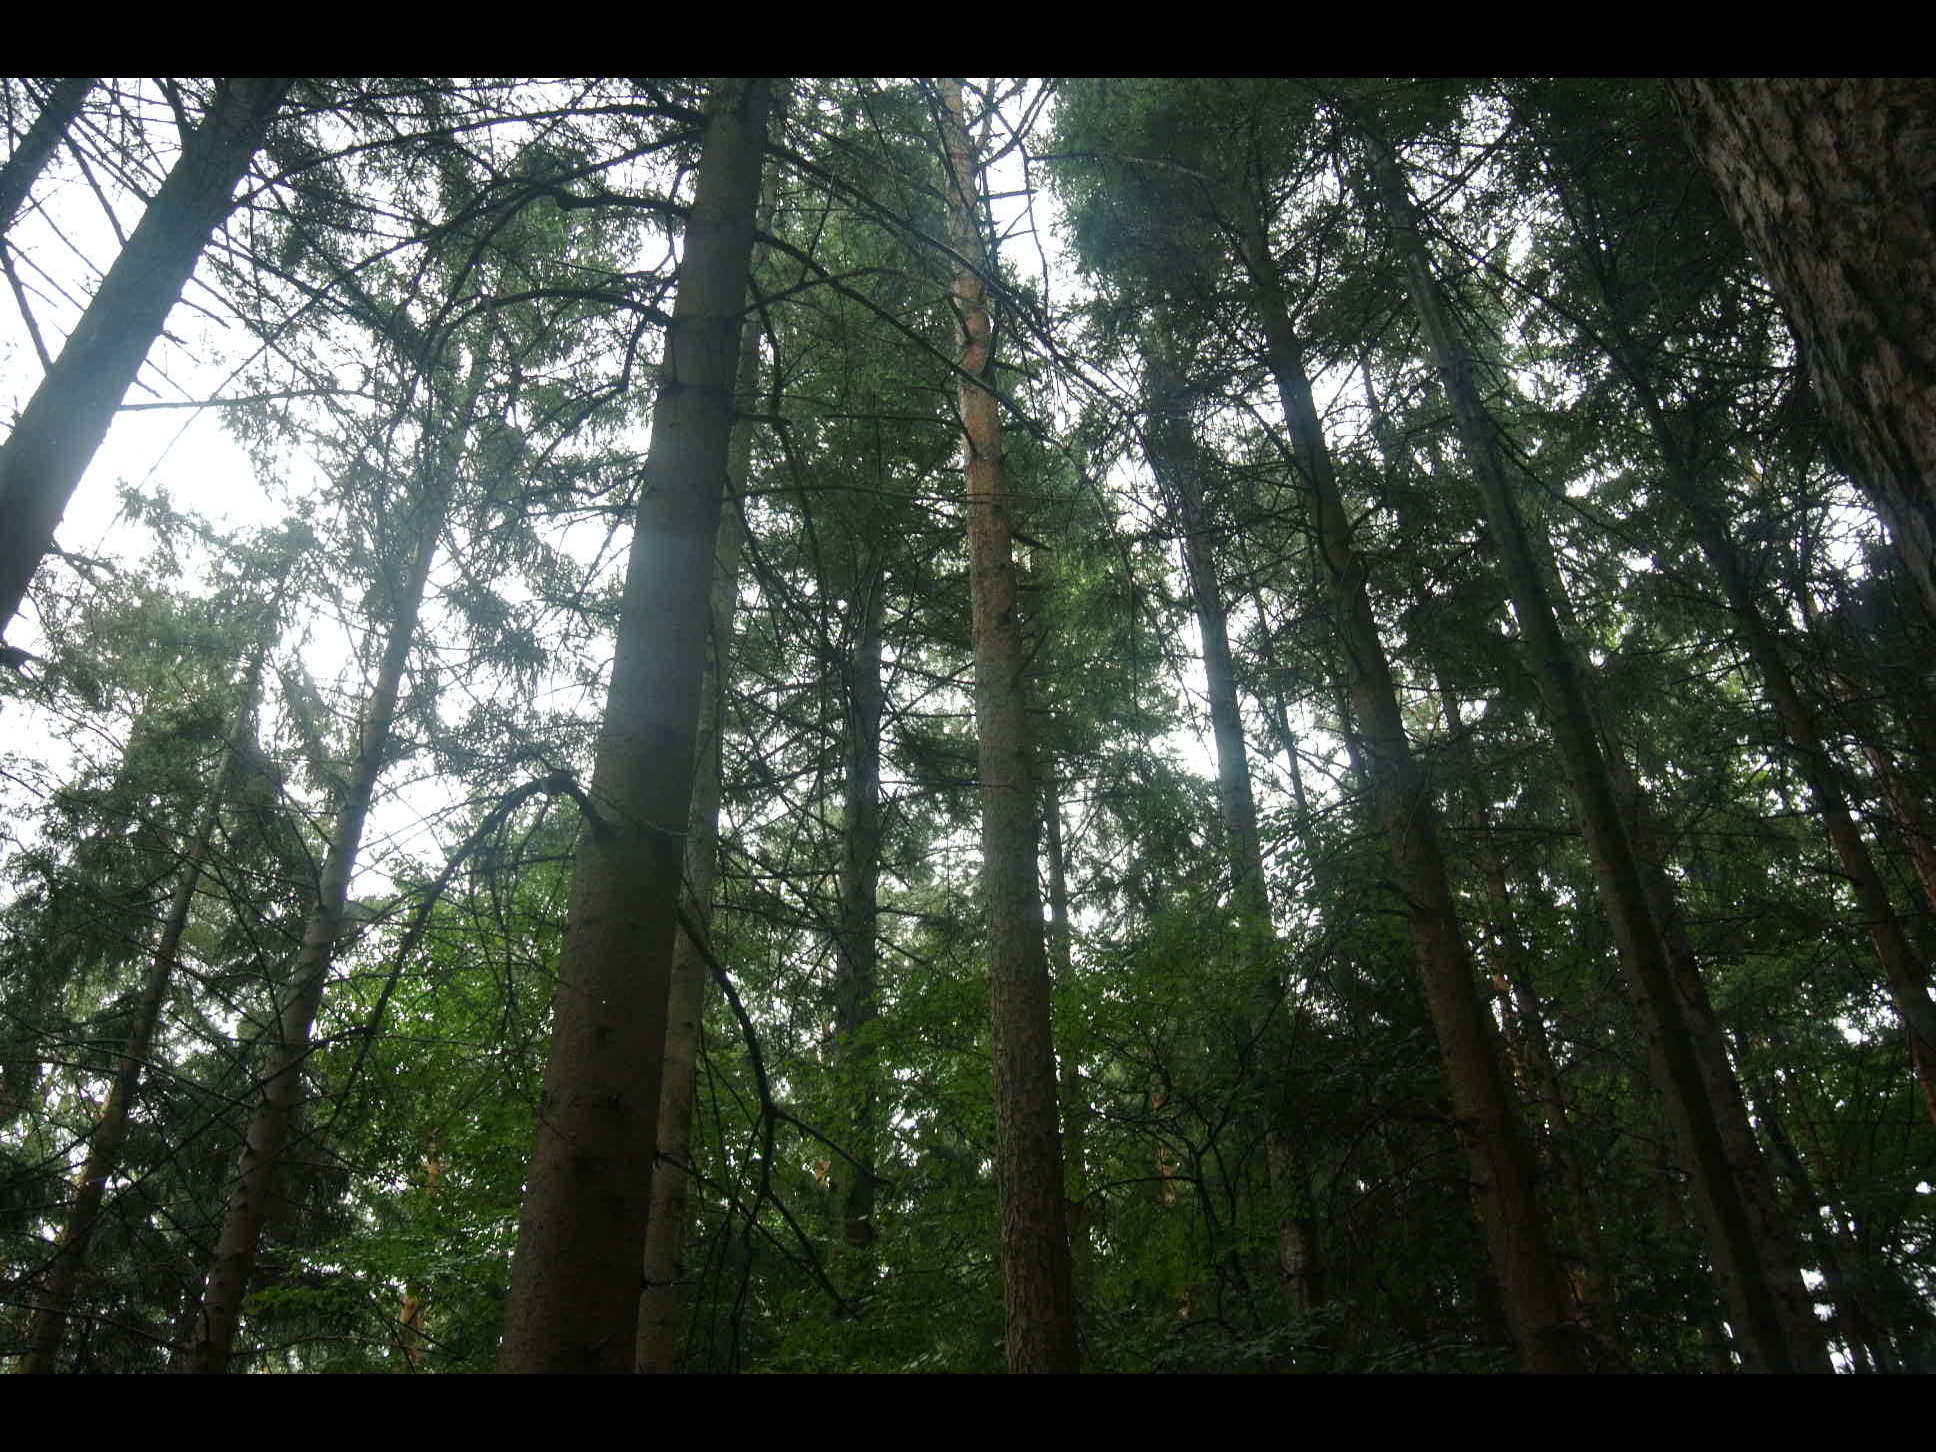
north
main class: Woodland
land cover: Spruce dominated coniferous woodland
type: alpine coniferous forest
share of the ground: > 75 %
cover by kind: coniferous forest trees 100 %
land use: Forestry
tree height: > 5 m
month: July
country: AT
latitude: 47.4566
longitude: 16.1439
